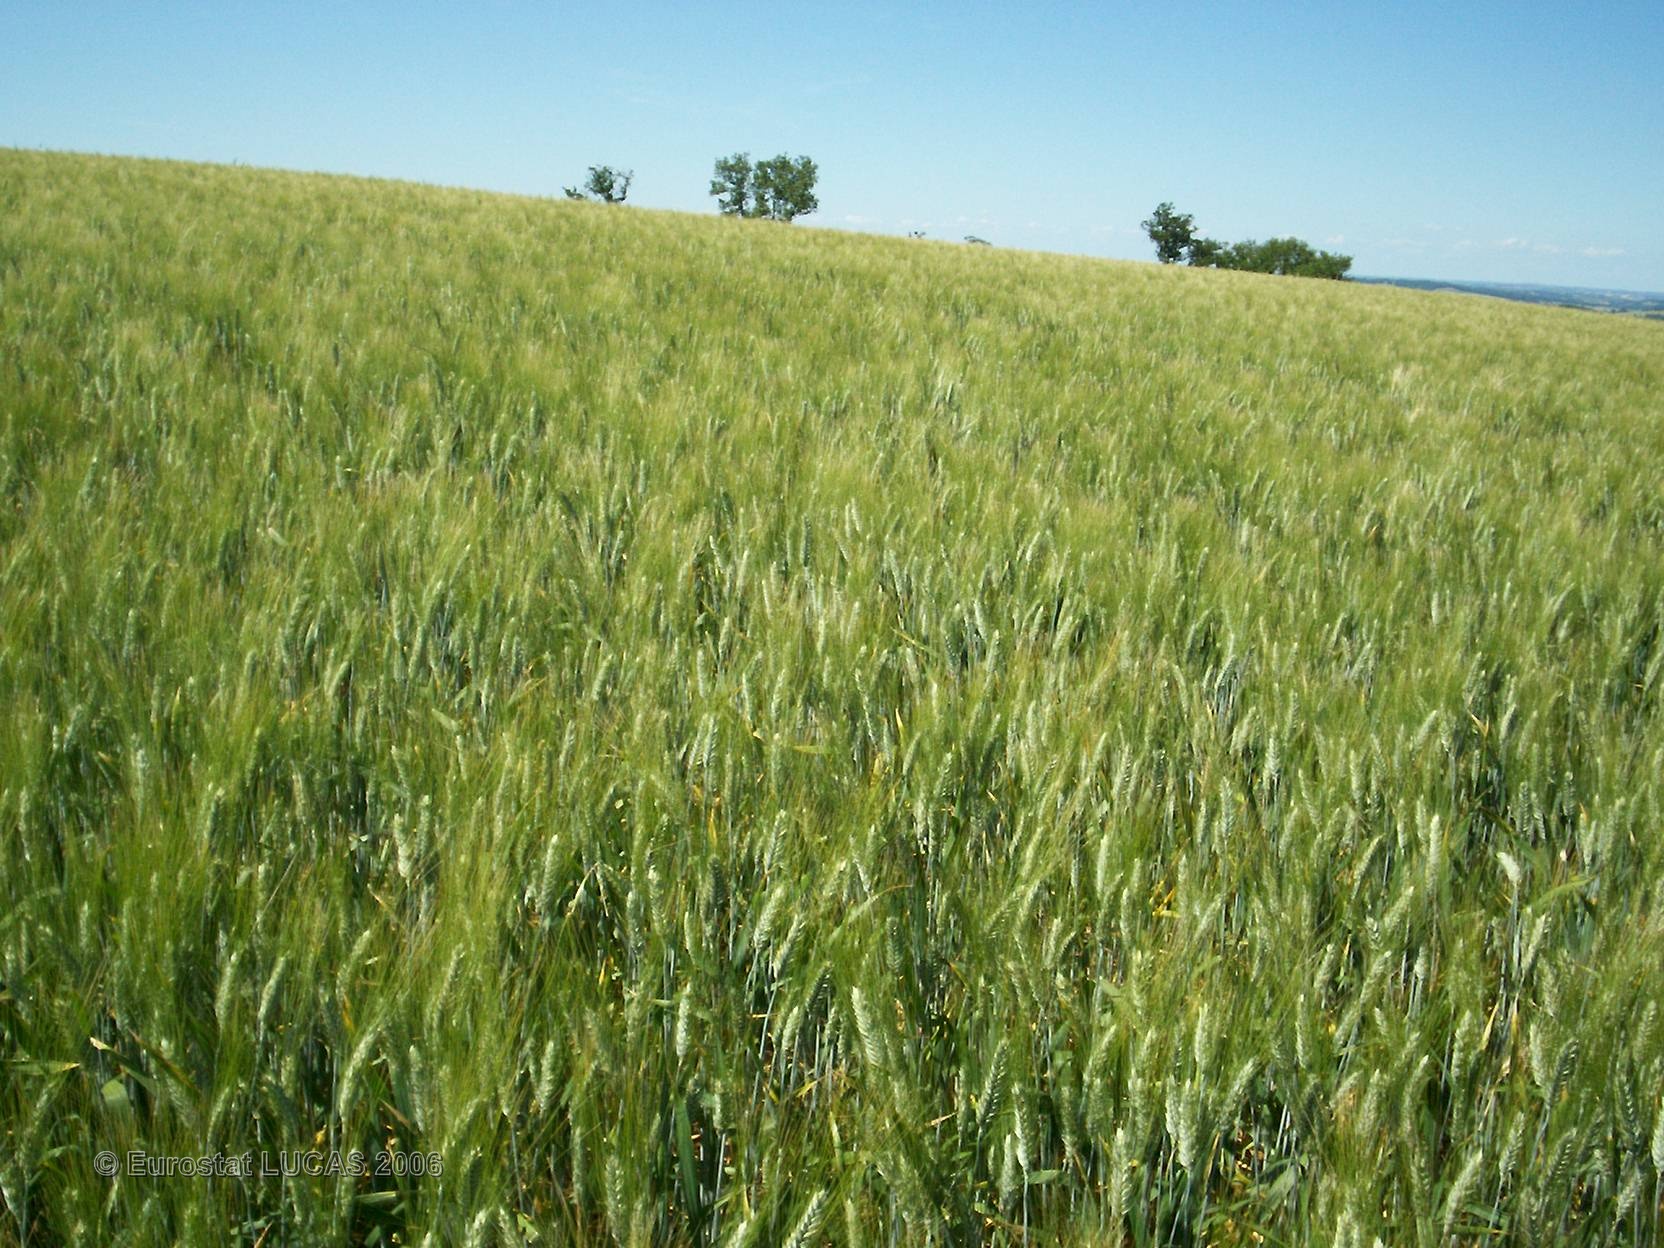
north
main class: Cropland
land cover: Durum wheat
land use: Agriculture (excluding fallow land and kitchen gardens)
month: June
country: FR
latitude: 43.9246
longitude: 0.8181
